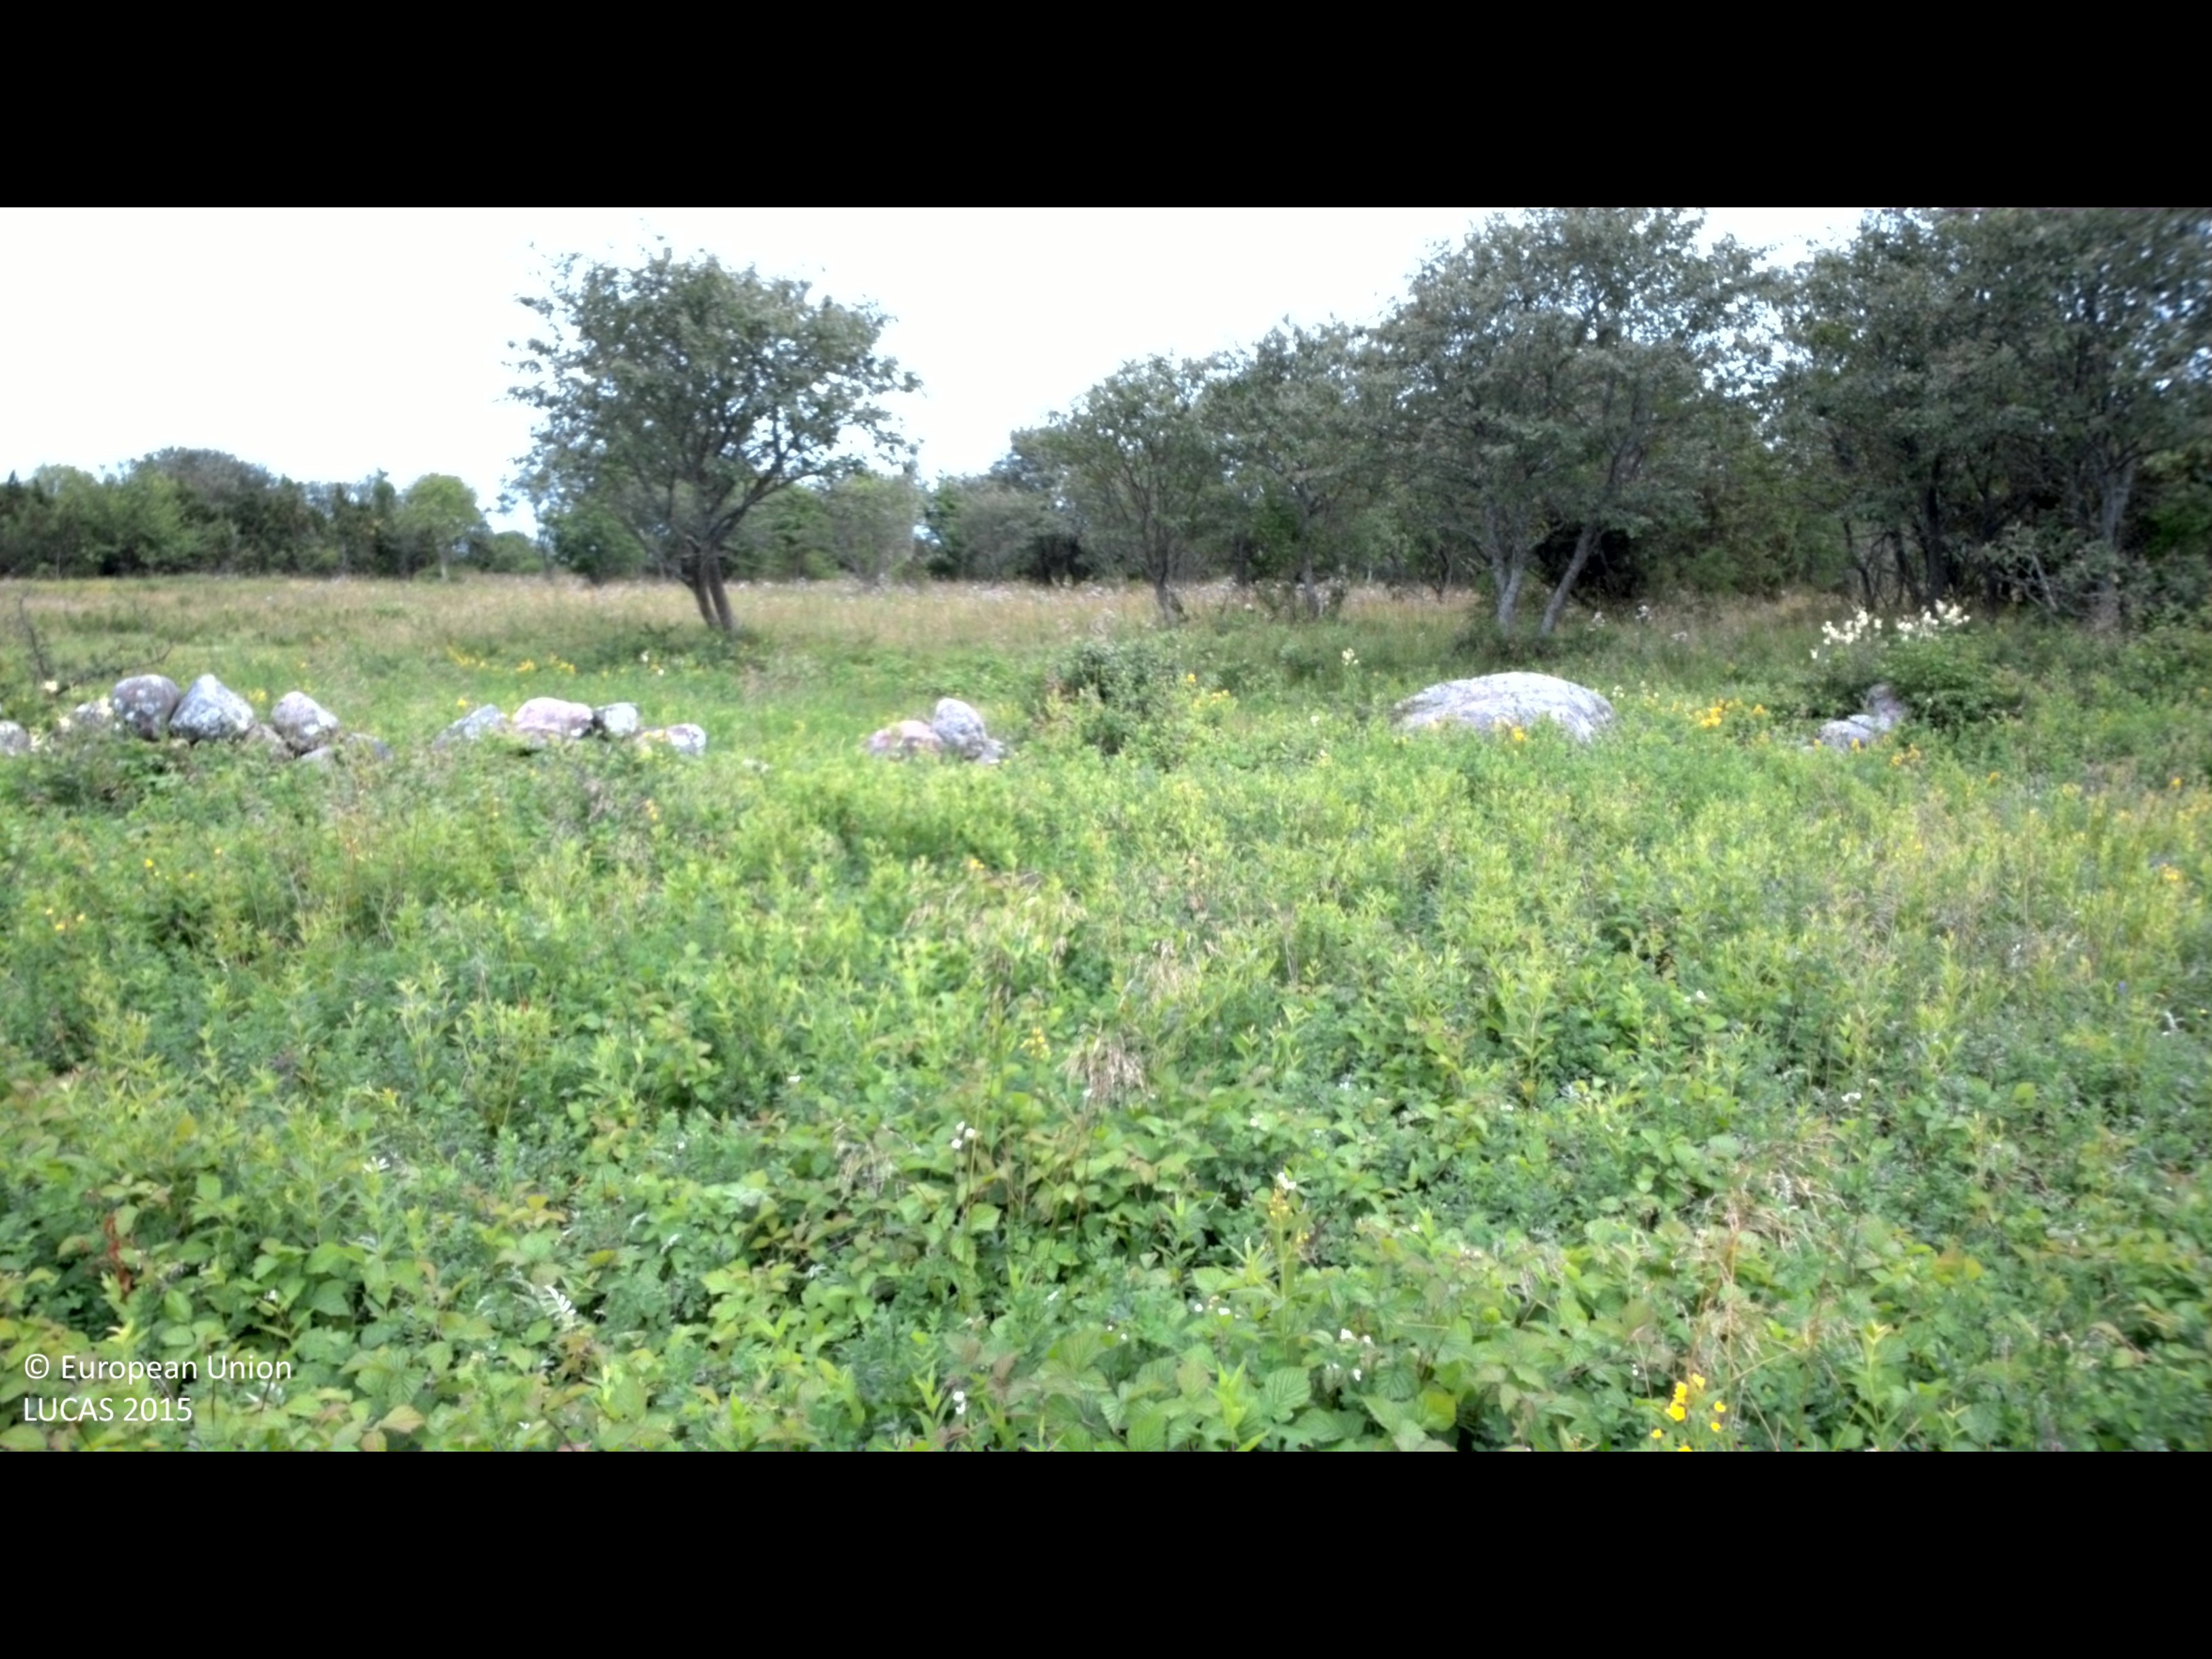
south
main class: Grassland
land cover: Grassland without tree/shrub cover
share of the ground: > 75 %
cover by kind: herbaceous plants 100 %
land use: Agriculture (excluding fallow land and kitchen gardens)
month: July
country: SE
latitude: 57.1328
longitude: 17.0238
